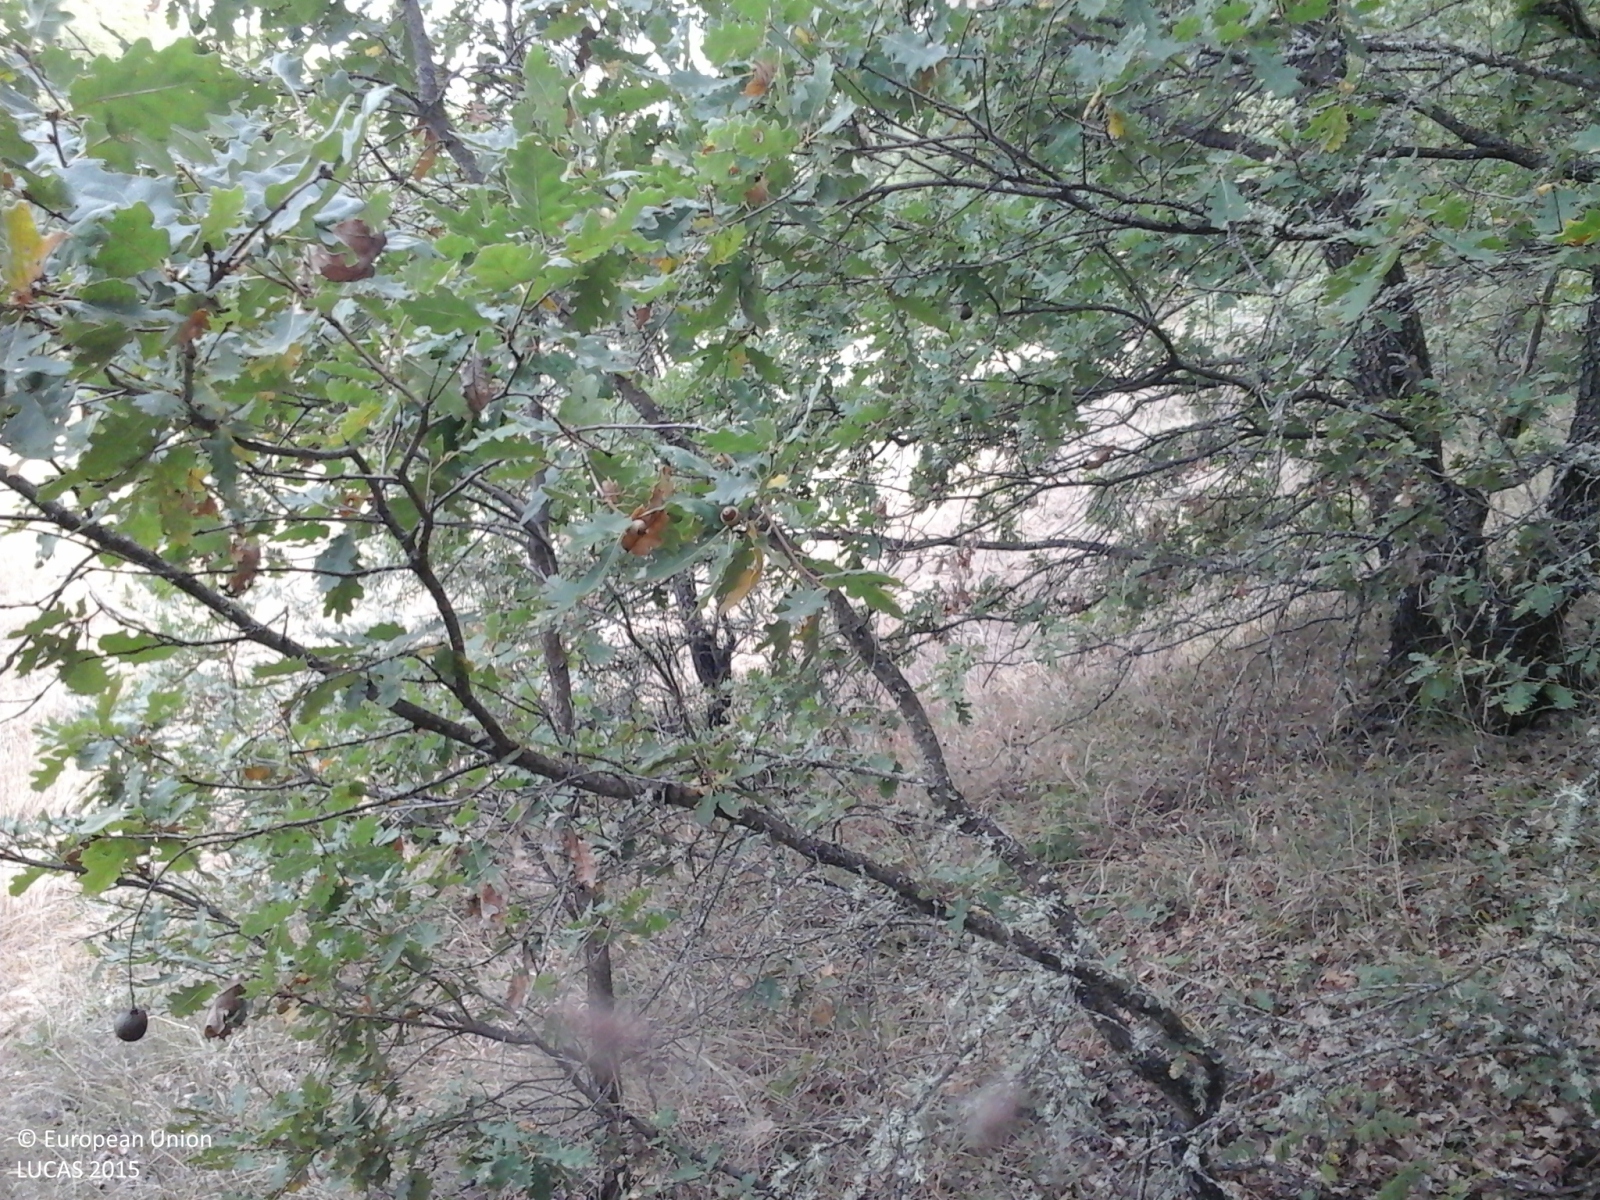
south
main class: Woodland
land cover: Broadleaved woodland
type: thermophilous deciduous forest
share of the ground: > 75 %
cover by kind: broadleaved forest trees 85 %, shrubs 5 %, herbaceous plants 5 %, unconsolidated bare surface 5 %
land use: Forestry
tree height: > 5 m
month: September
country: GR
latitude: 40.1606
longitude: 21.2929
